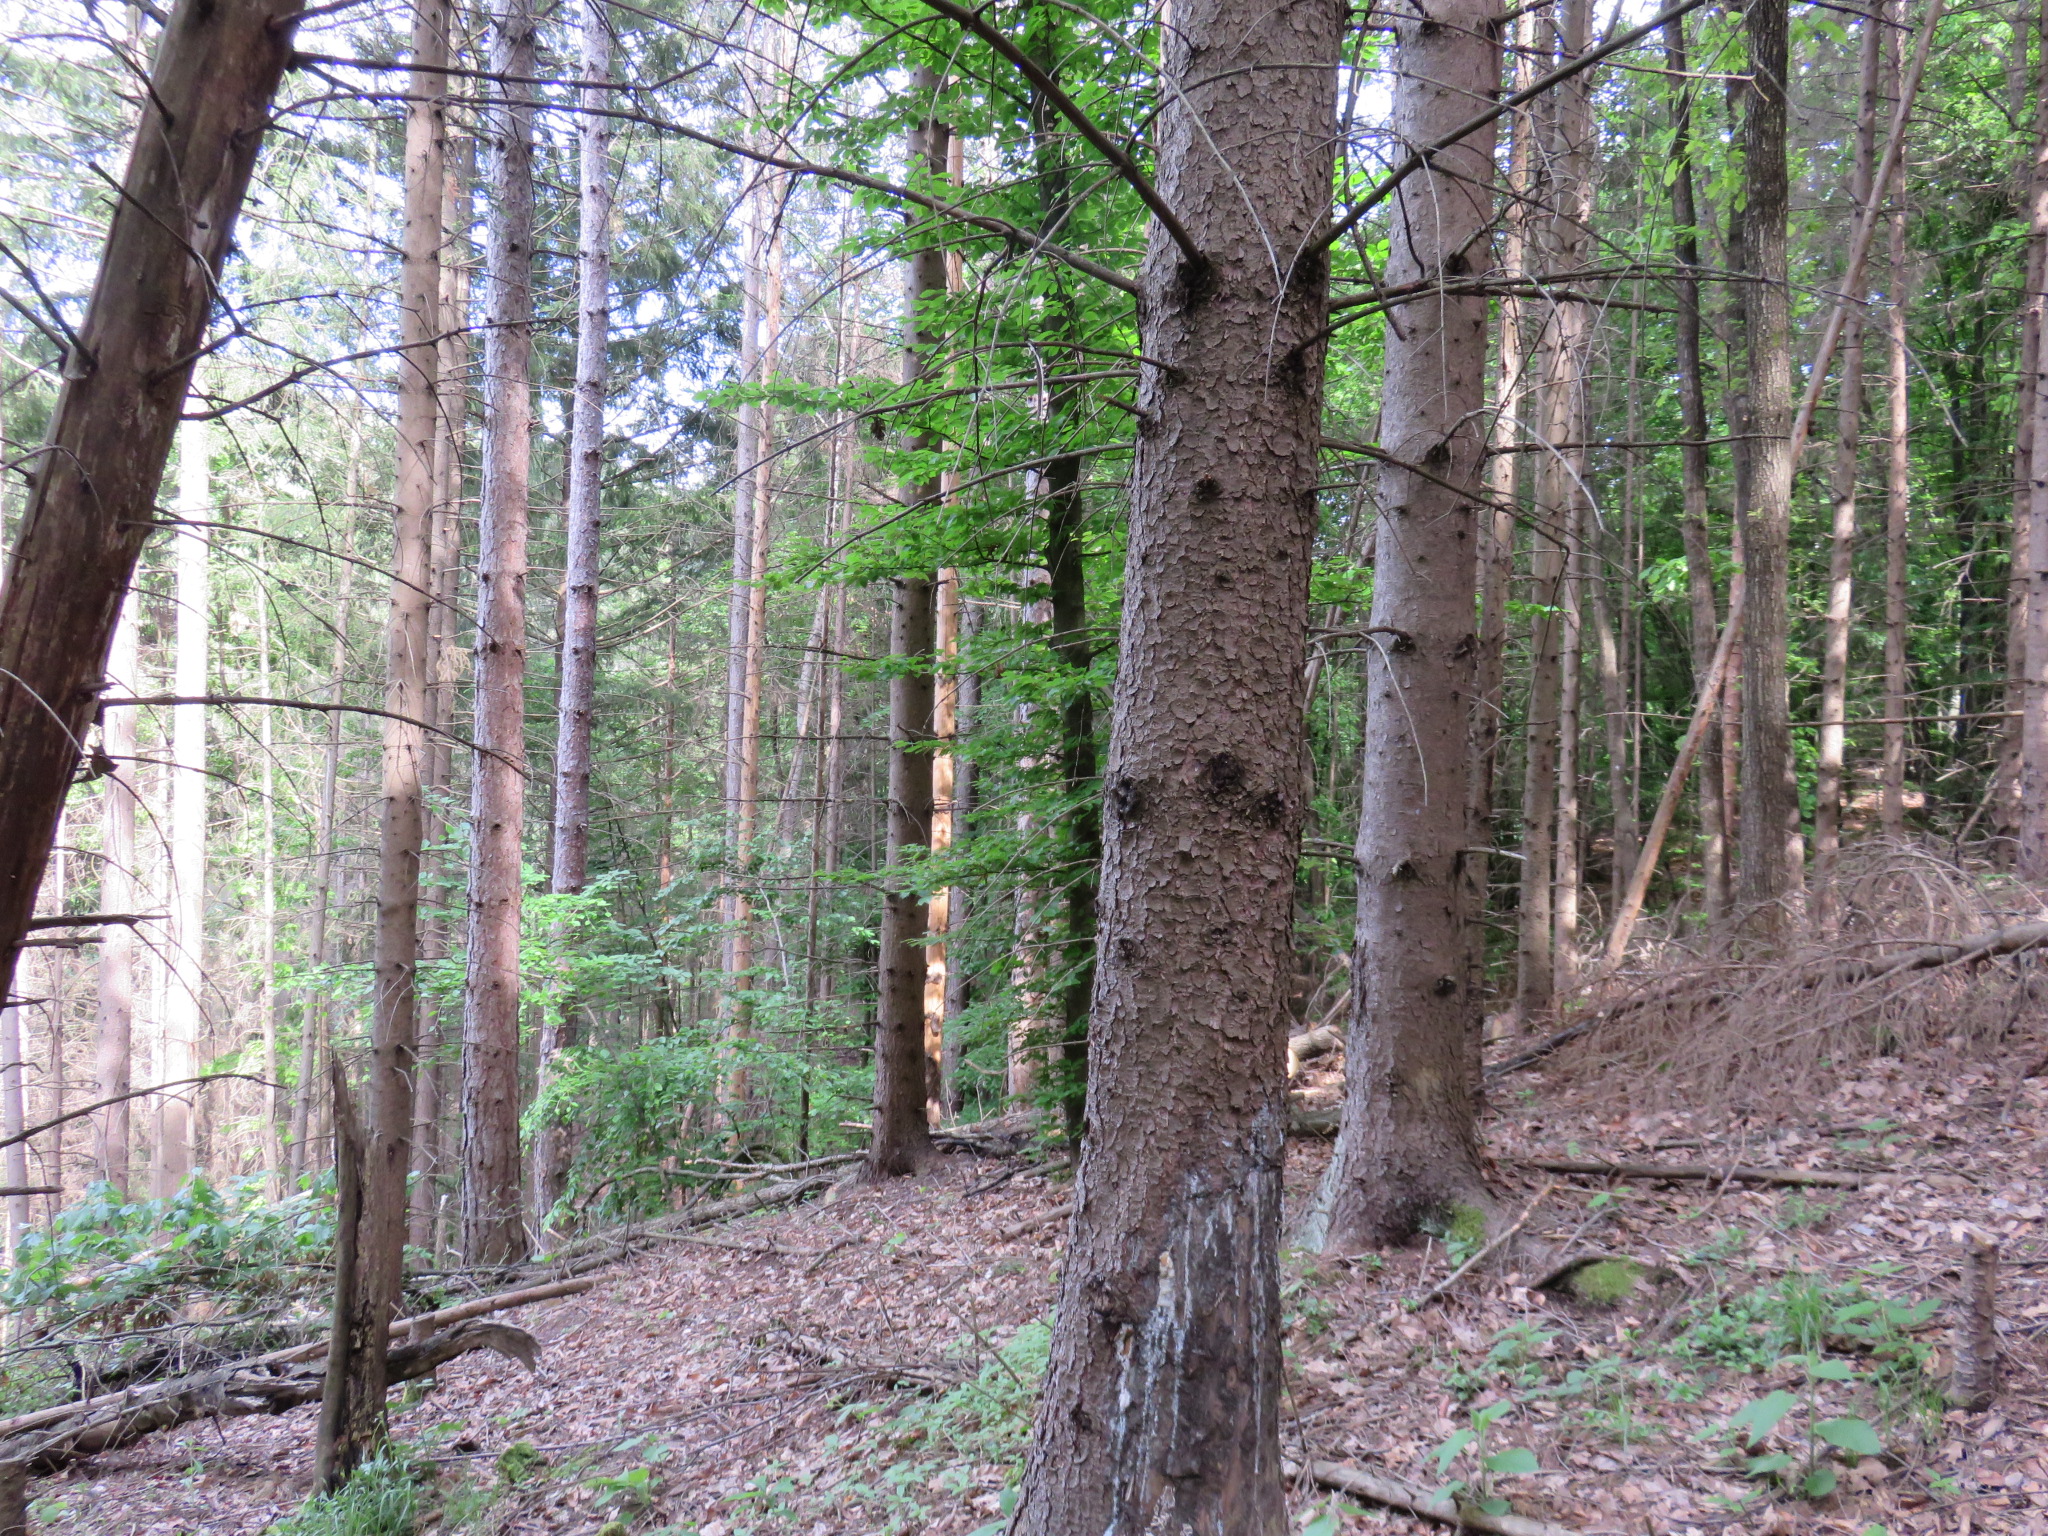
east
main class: Woodland
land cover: Spruce dominated coniferous woodland
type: hemiboreal forest and nemoral coniferous forest and mixed broadleaved-coniferous forest
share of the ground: > 75 %
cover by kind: coniferous forest trees 80 %, broadleaved forest trees 10 %, unconsolidated bare surface 10 %
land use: Forestry
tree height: > 5 m
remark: Clear cut
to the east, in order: Spruce dominated coniferous woodland; Rivers and streams; Broadleaved woodland; Tracks; Broadleaved woodland; Rivers and streams; Broadleaved woodland; Grassland with sparse tree/shrub cover; Other fruit trees and berries; Grassland without tree/shrub cover
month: May
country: BG
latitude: 42.8456
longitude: 24.7800
